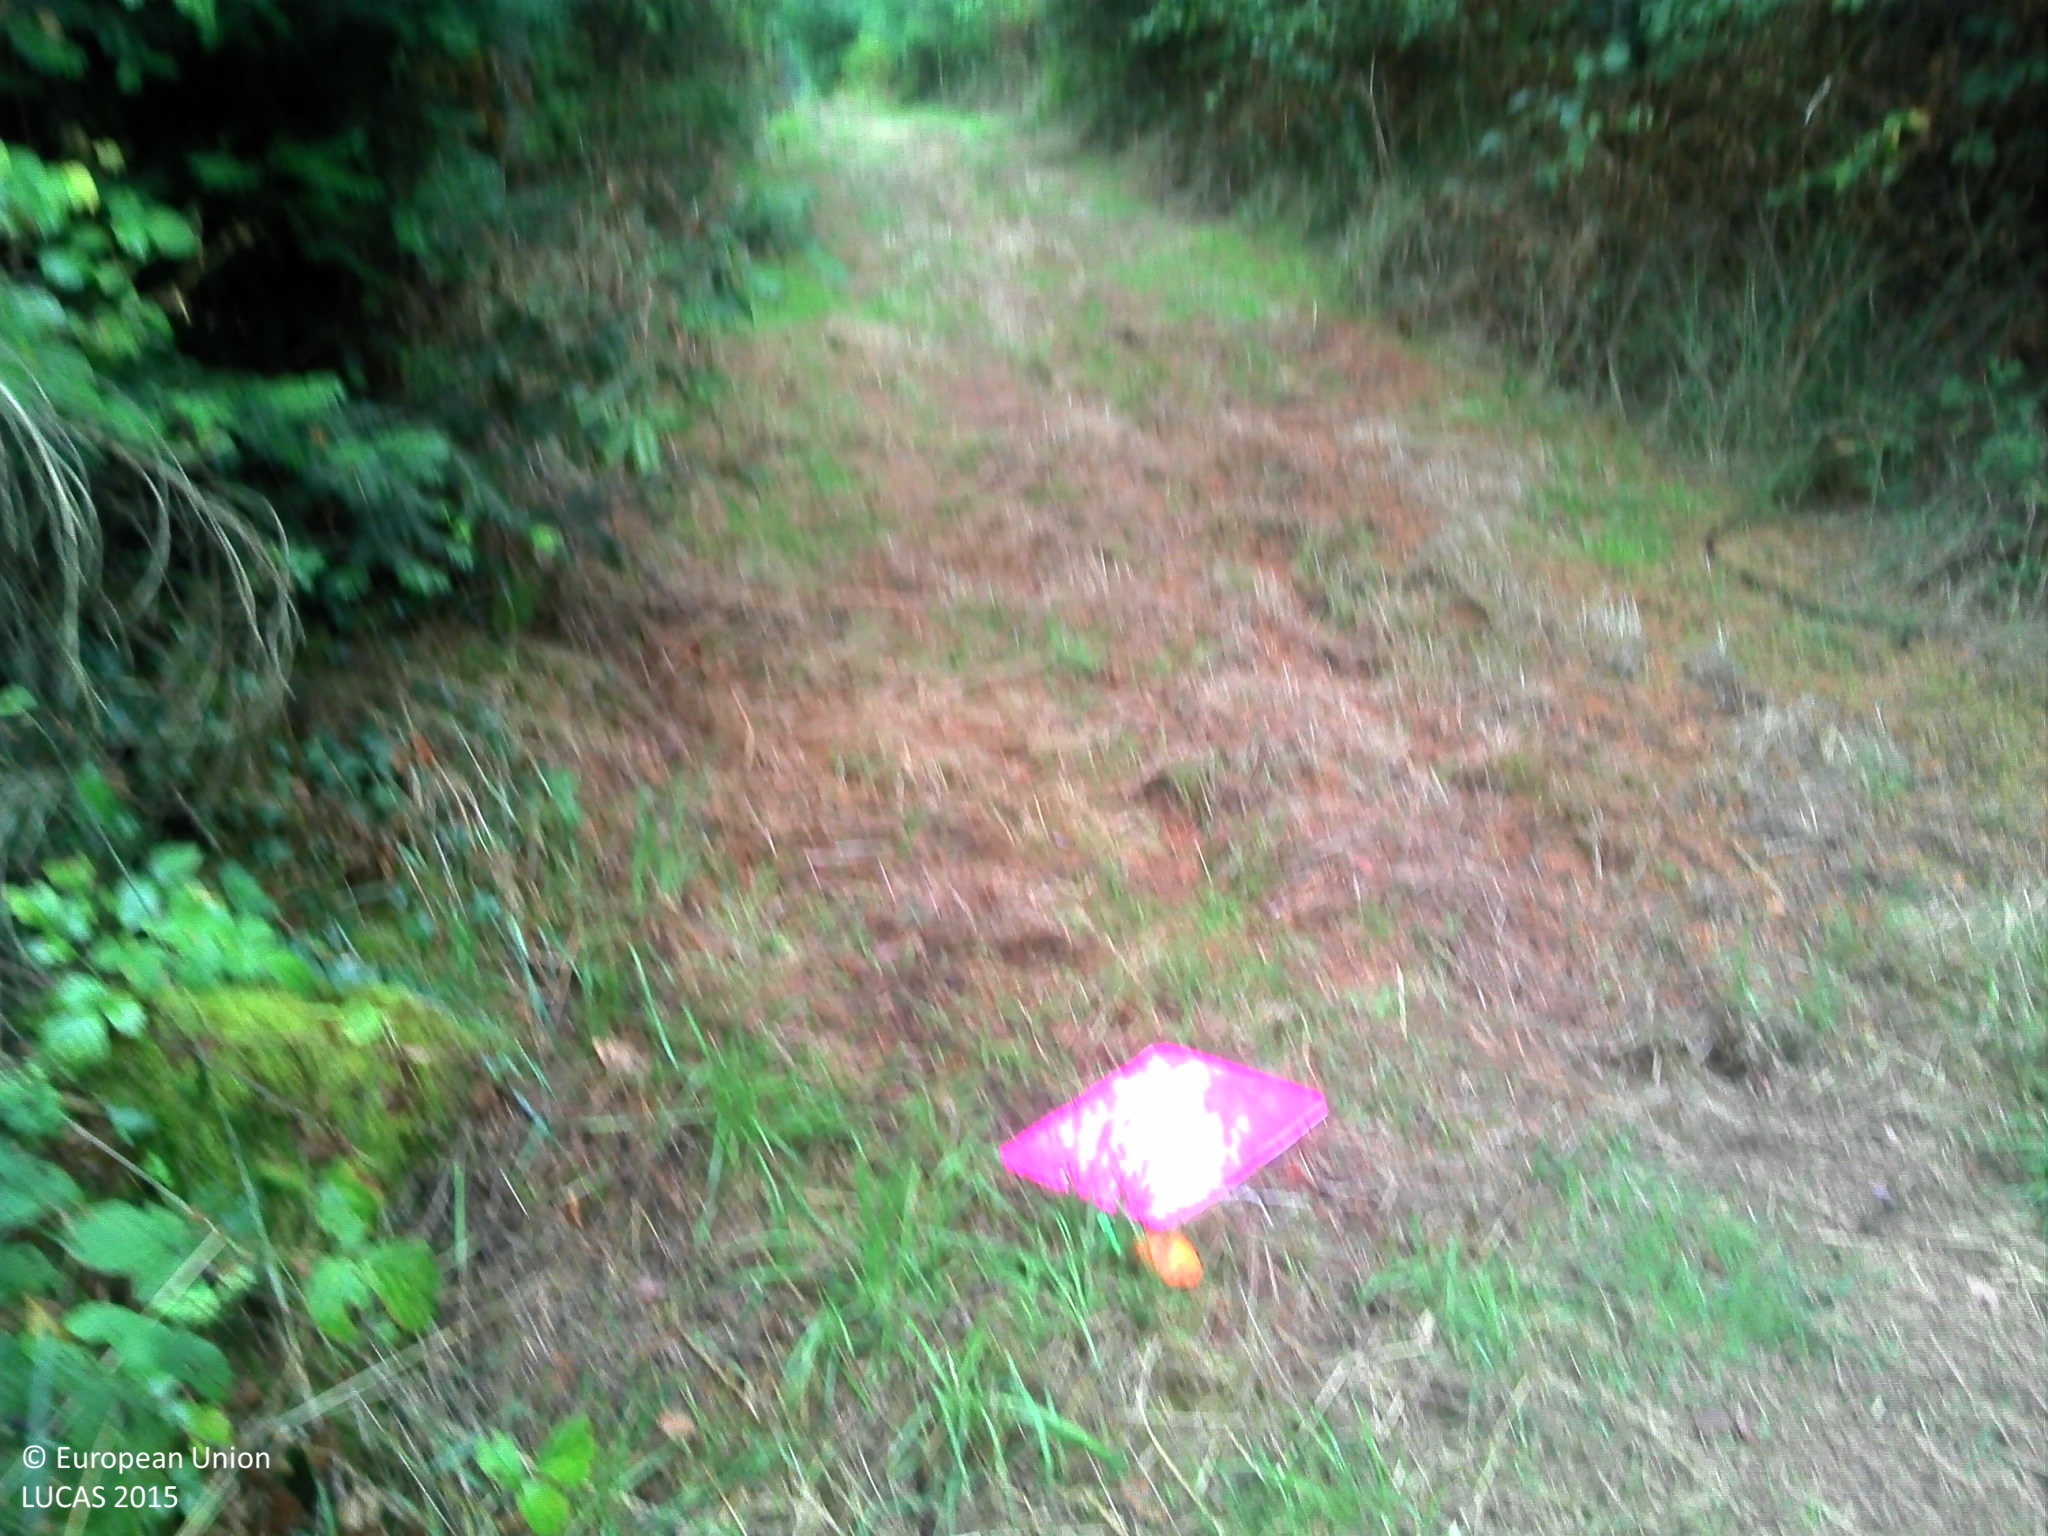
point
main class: Woodland
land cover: Spruce dominated coniferous woodland
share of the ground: > 75 %
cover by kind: coniferous forest trees 95 %, broadleaved forest trees 5 %
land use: Forestry
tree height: > 5 m
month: August
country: FR
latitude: 46.0063
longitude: 0.9873
